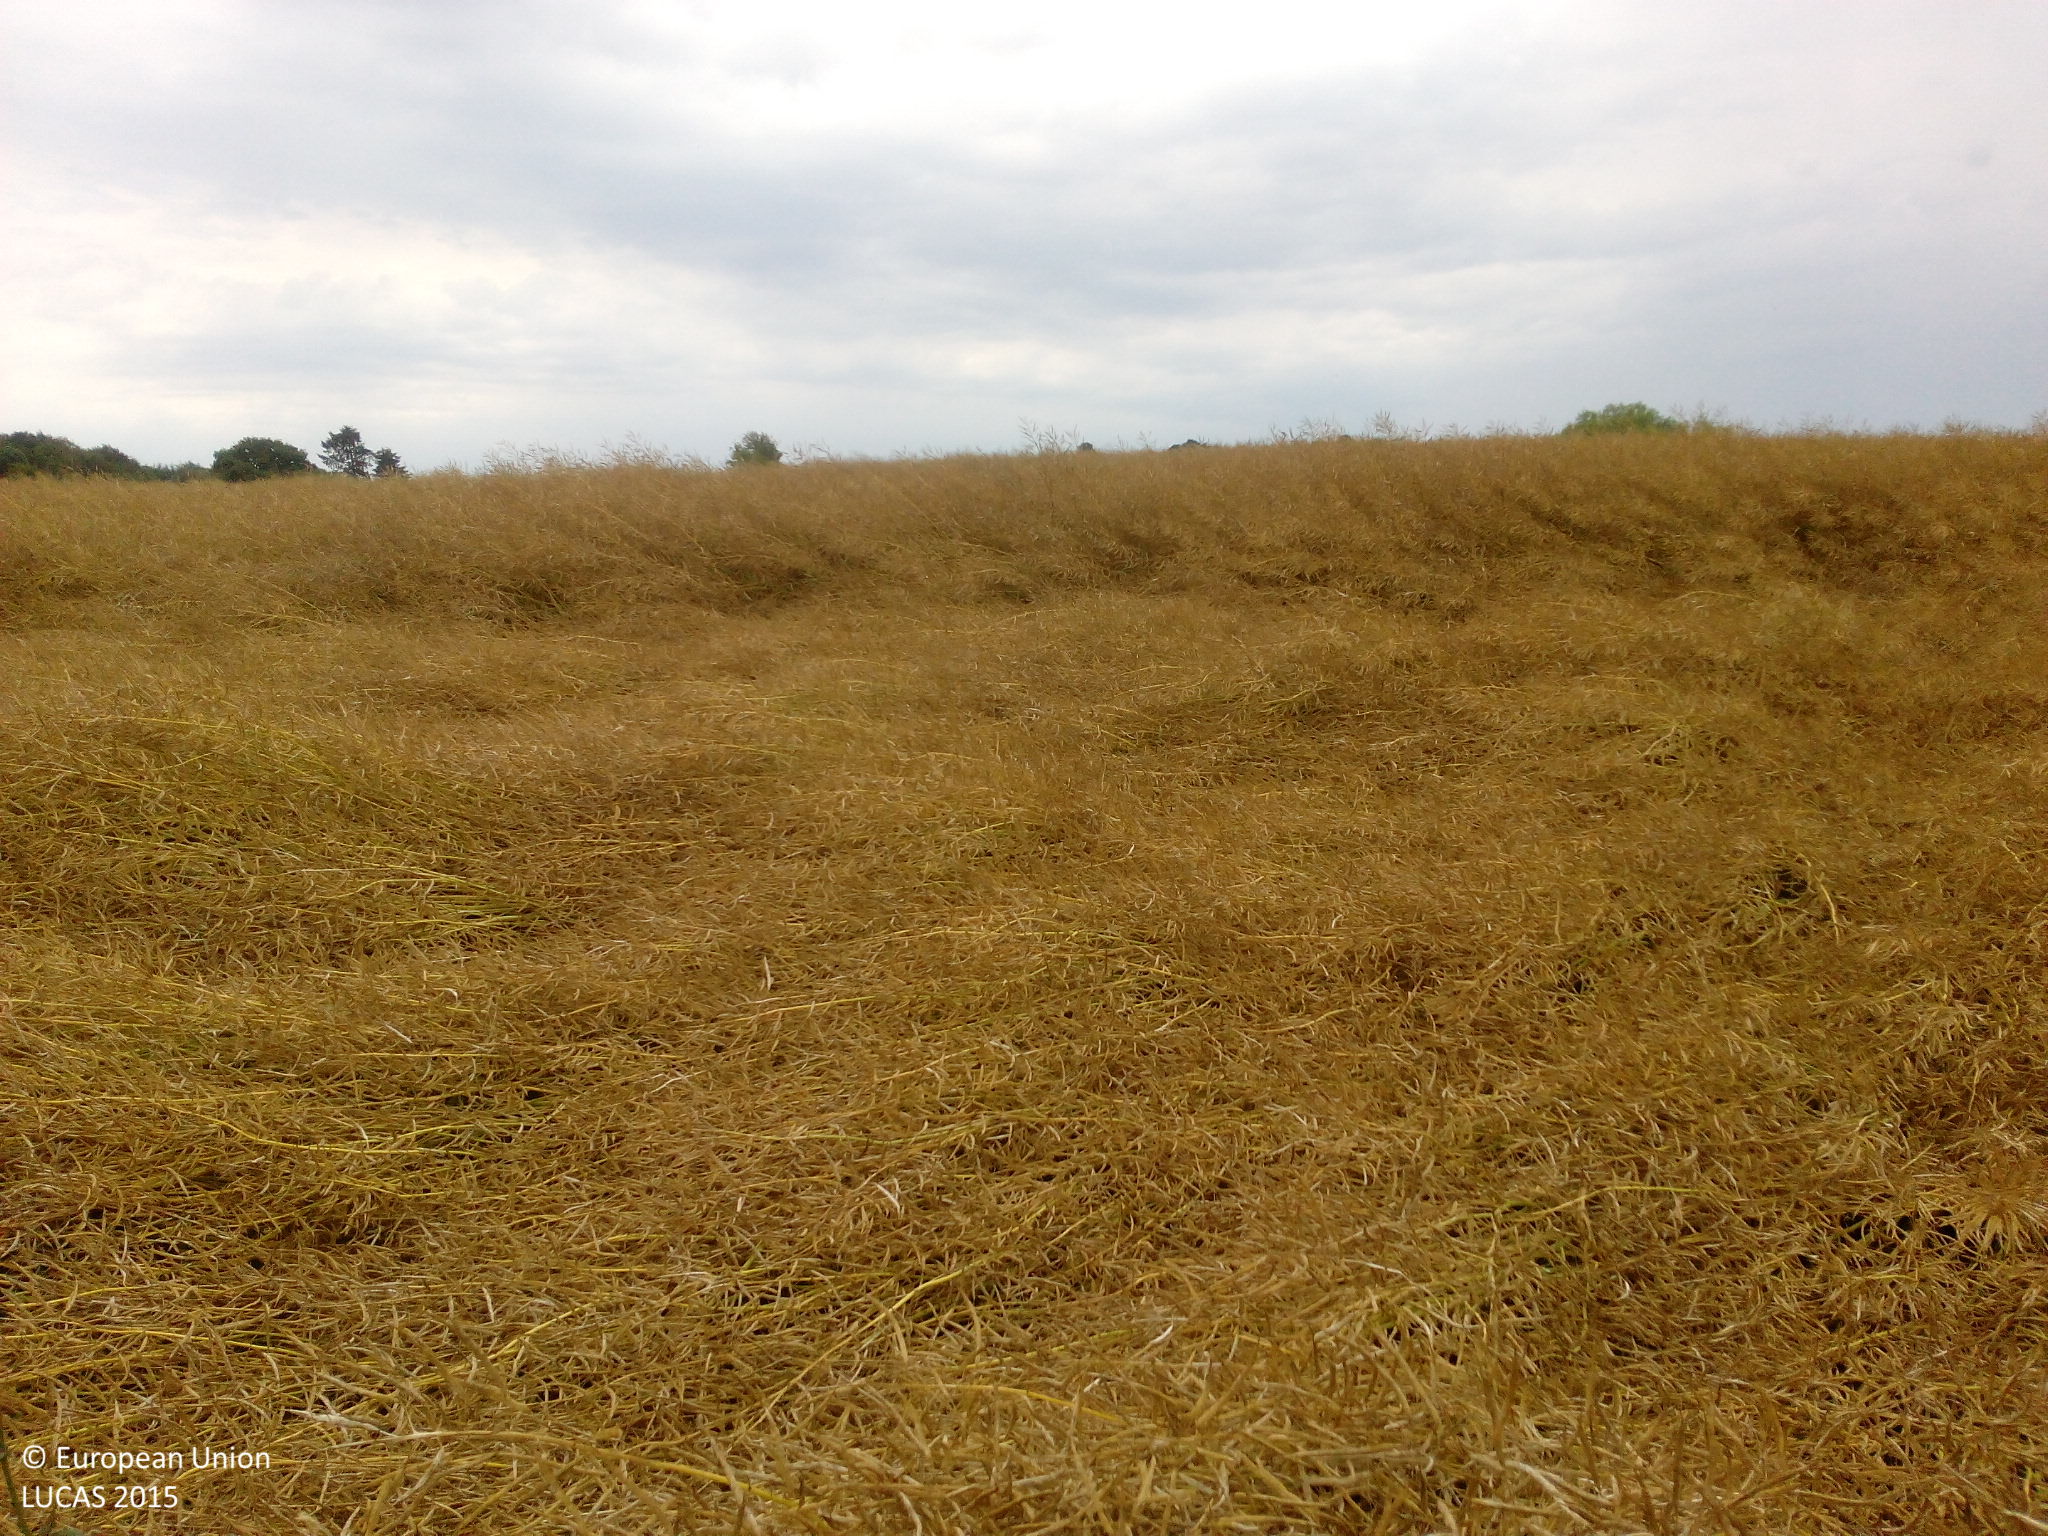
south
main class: Cropland
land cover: Rape and turnip rape
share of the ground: > 75 %
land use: Agriculture (excluding fallow land and kitchen gardens)
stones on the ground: < 10 %
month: August
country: DK
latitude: 55.5267
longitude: 11.8835
